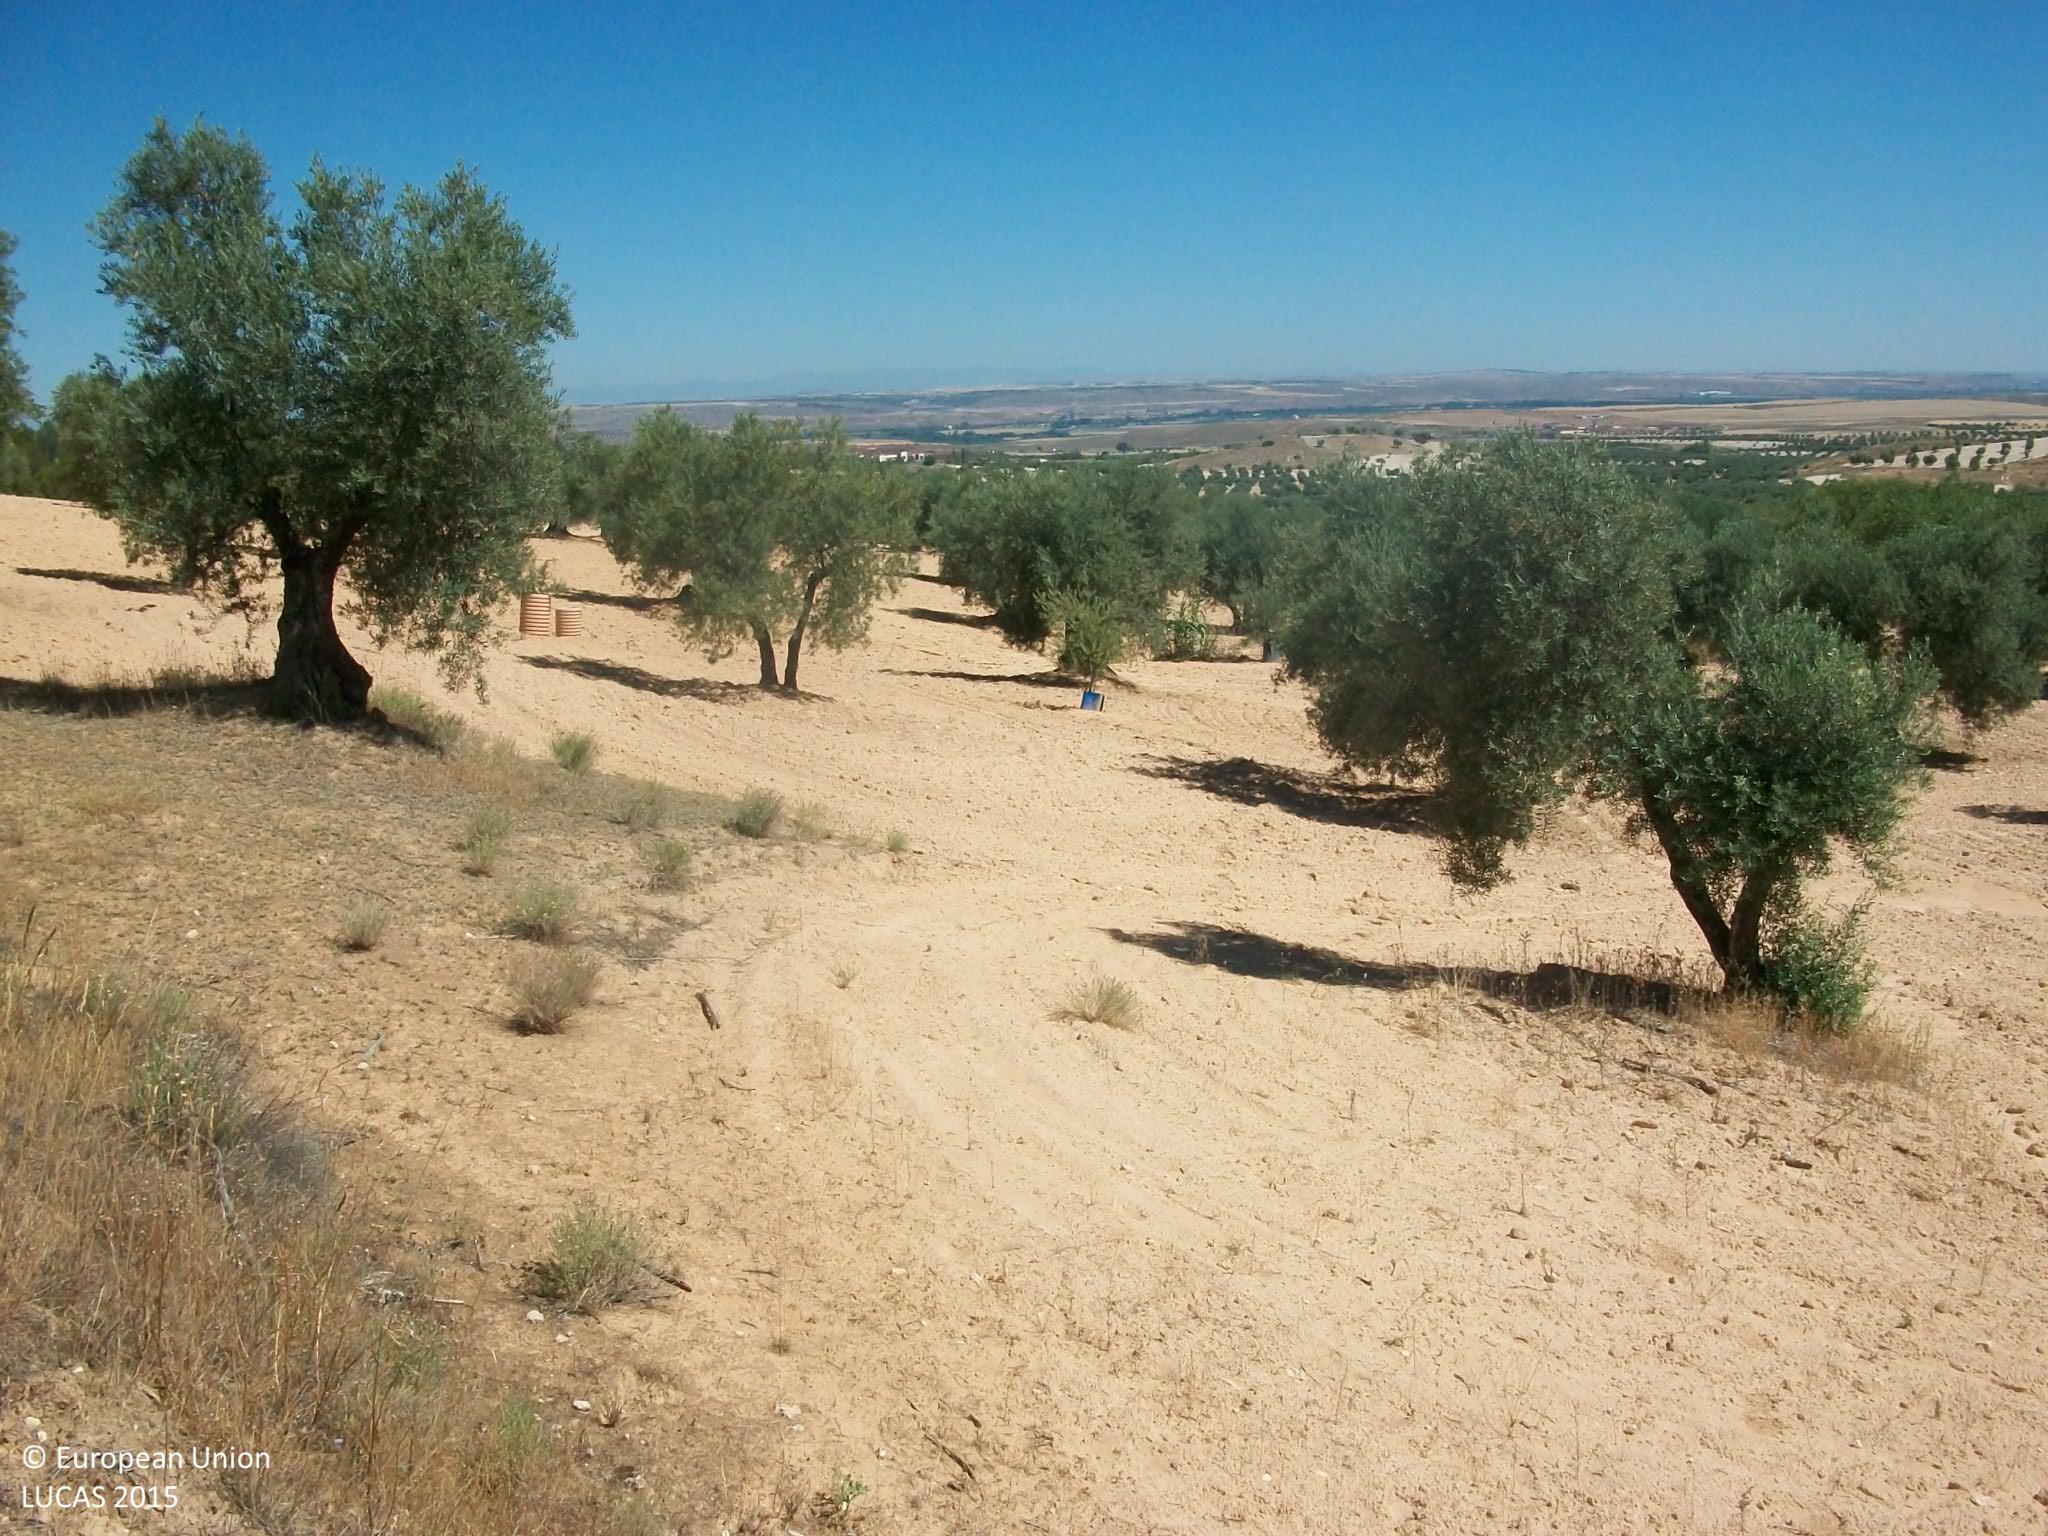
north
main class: Cropland
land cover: Olive groves
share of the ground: 25 - 50 %
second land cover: Other bare soil
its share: > 75 %
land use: Agriculture (excluding fallow land and kitchen gardens)
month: June
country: ES
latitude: 39.9230
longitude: -3.7085
